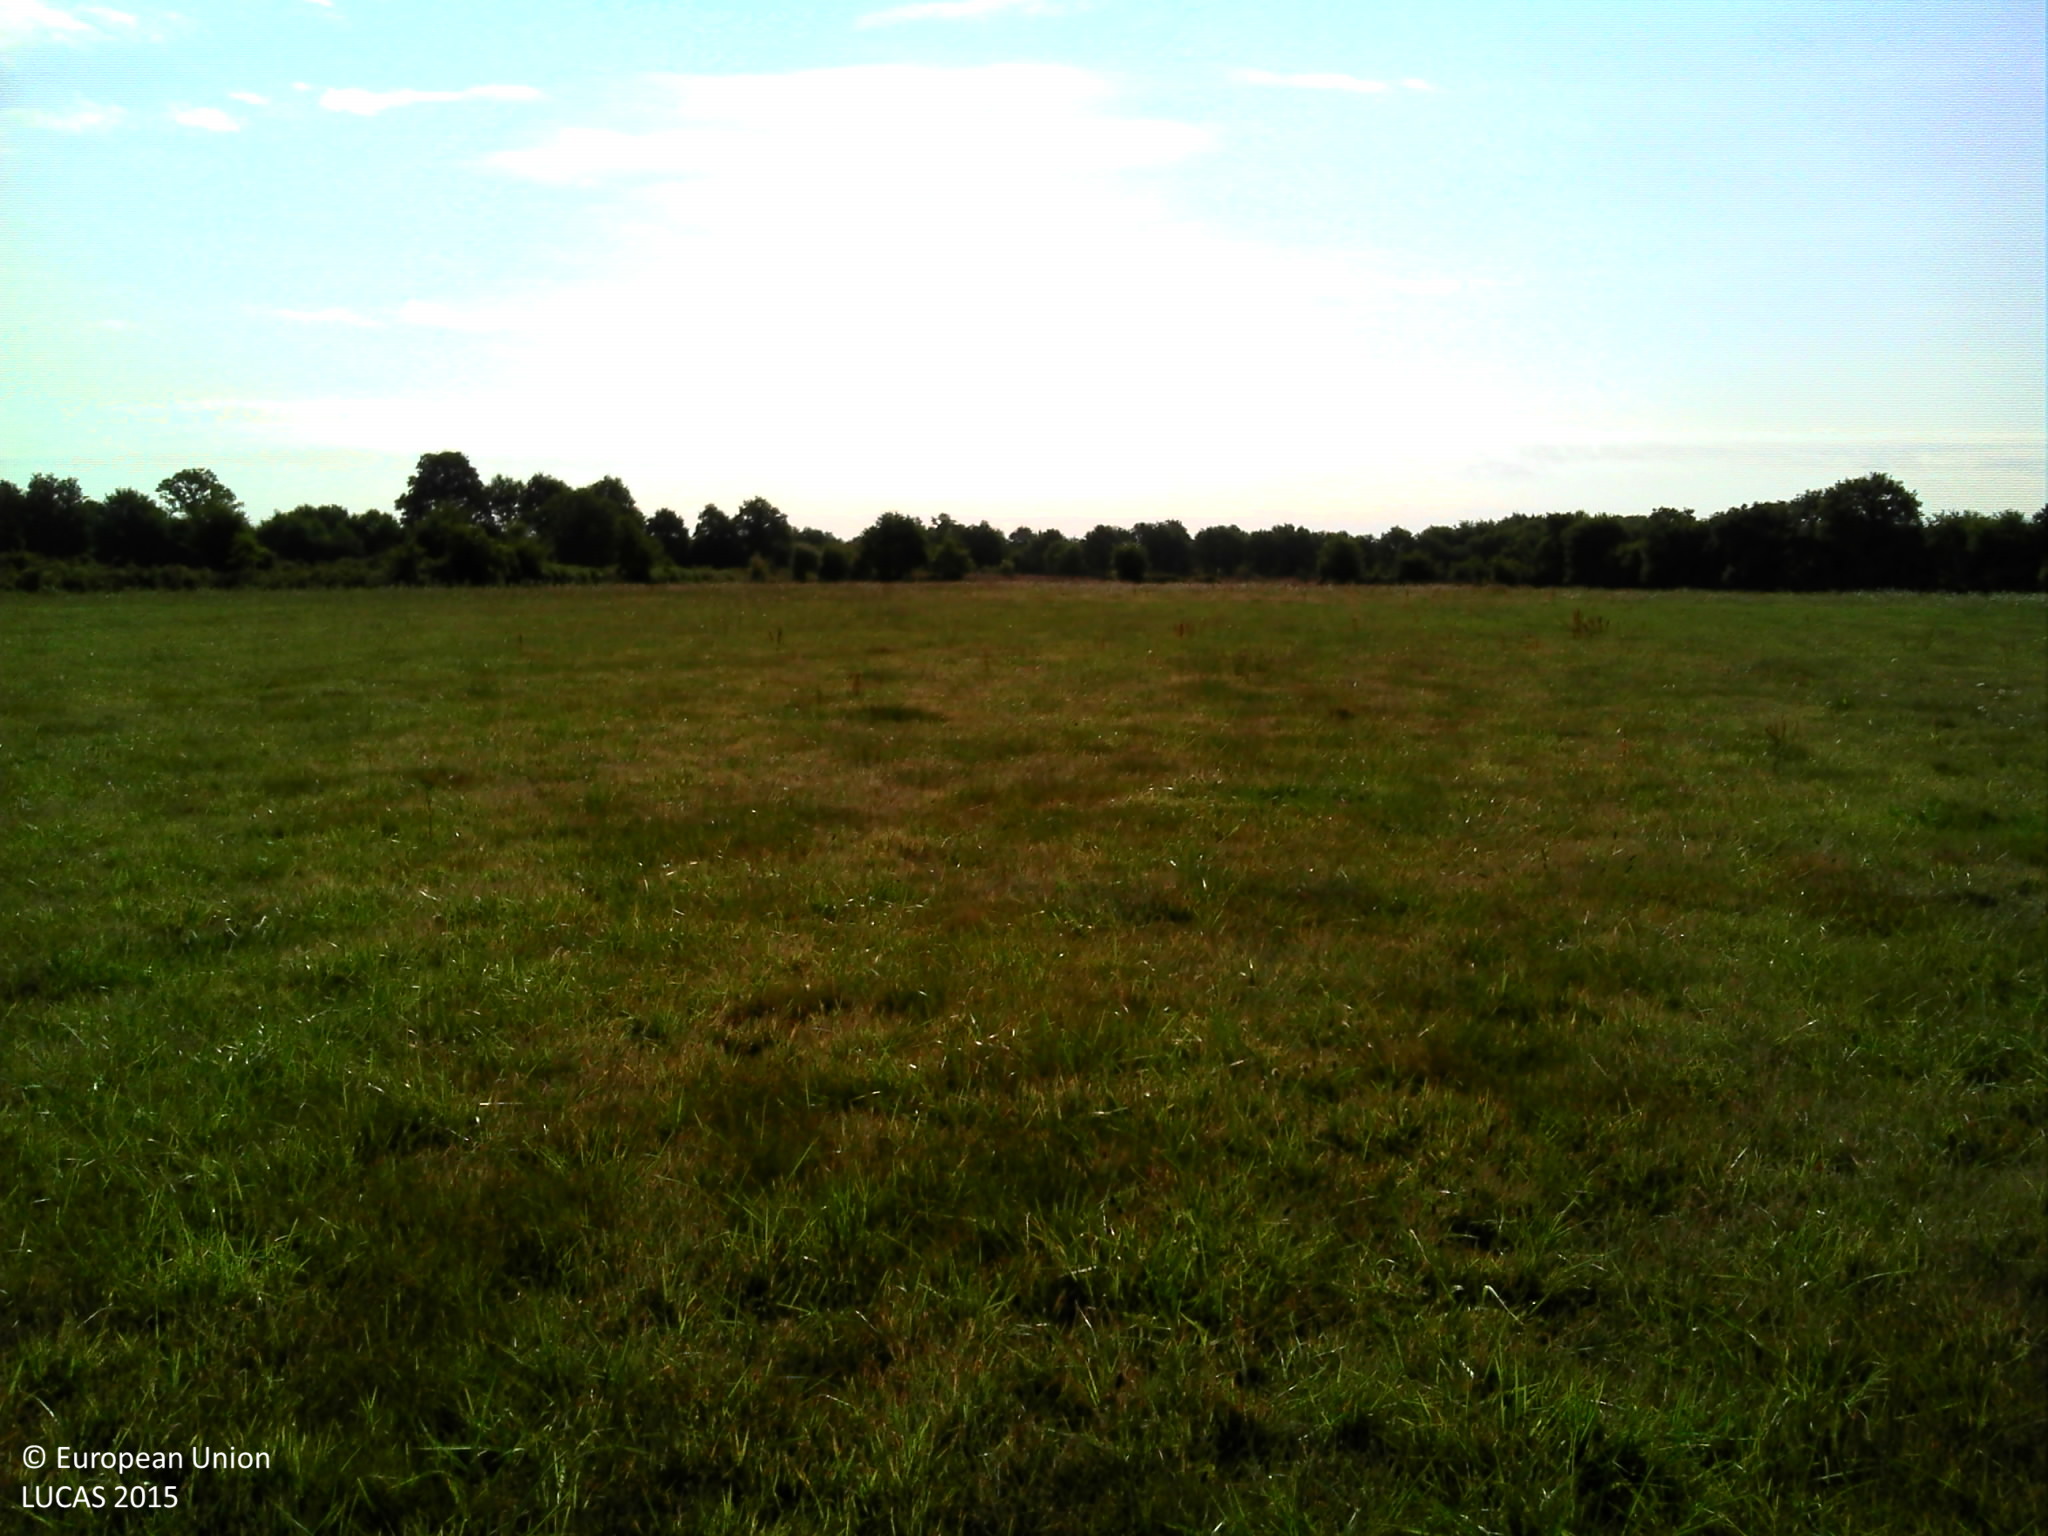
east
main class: Cropland
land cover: Temporary grasslands
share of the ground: > 75 %
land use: Agriculture (excluding fallow land and kitchen gardens)
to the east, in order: Temporary grasslands; Abandoned hedges; Ditches and canals; Grass margins; Tracks; Grass margins; Ditches and canals; Abandoned hedges; Fences; Grassland without tree/shrub cover
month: August
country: FR
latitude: 47.4409
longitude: -1.8086
